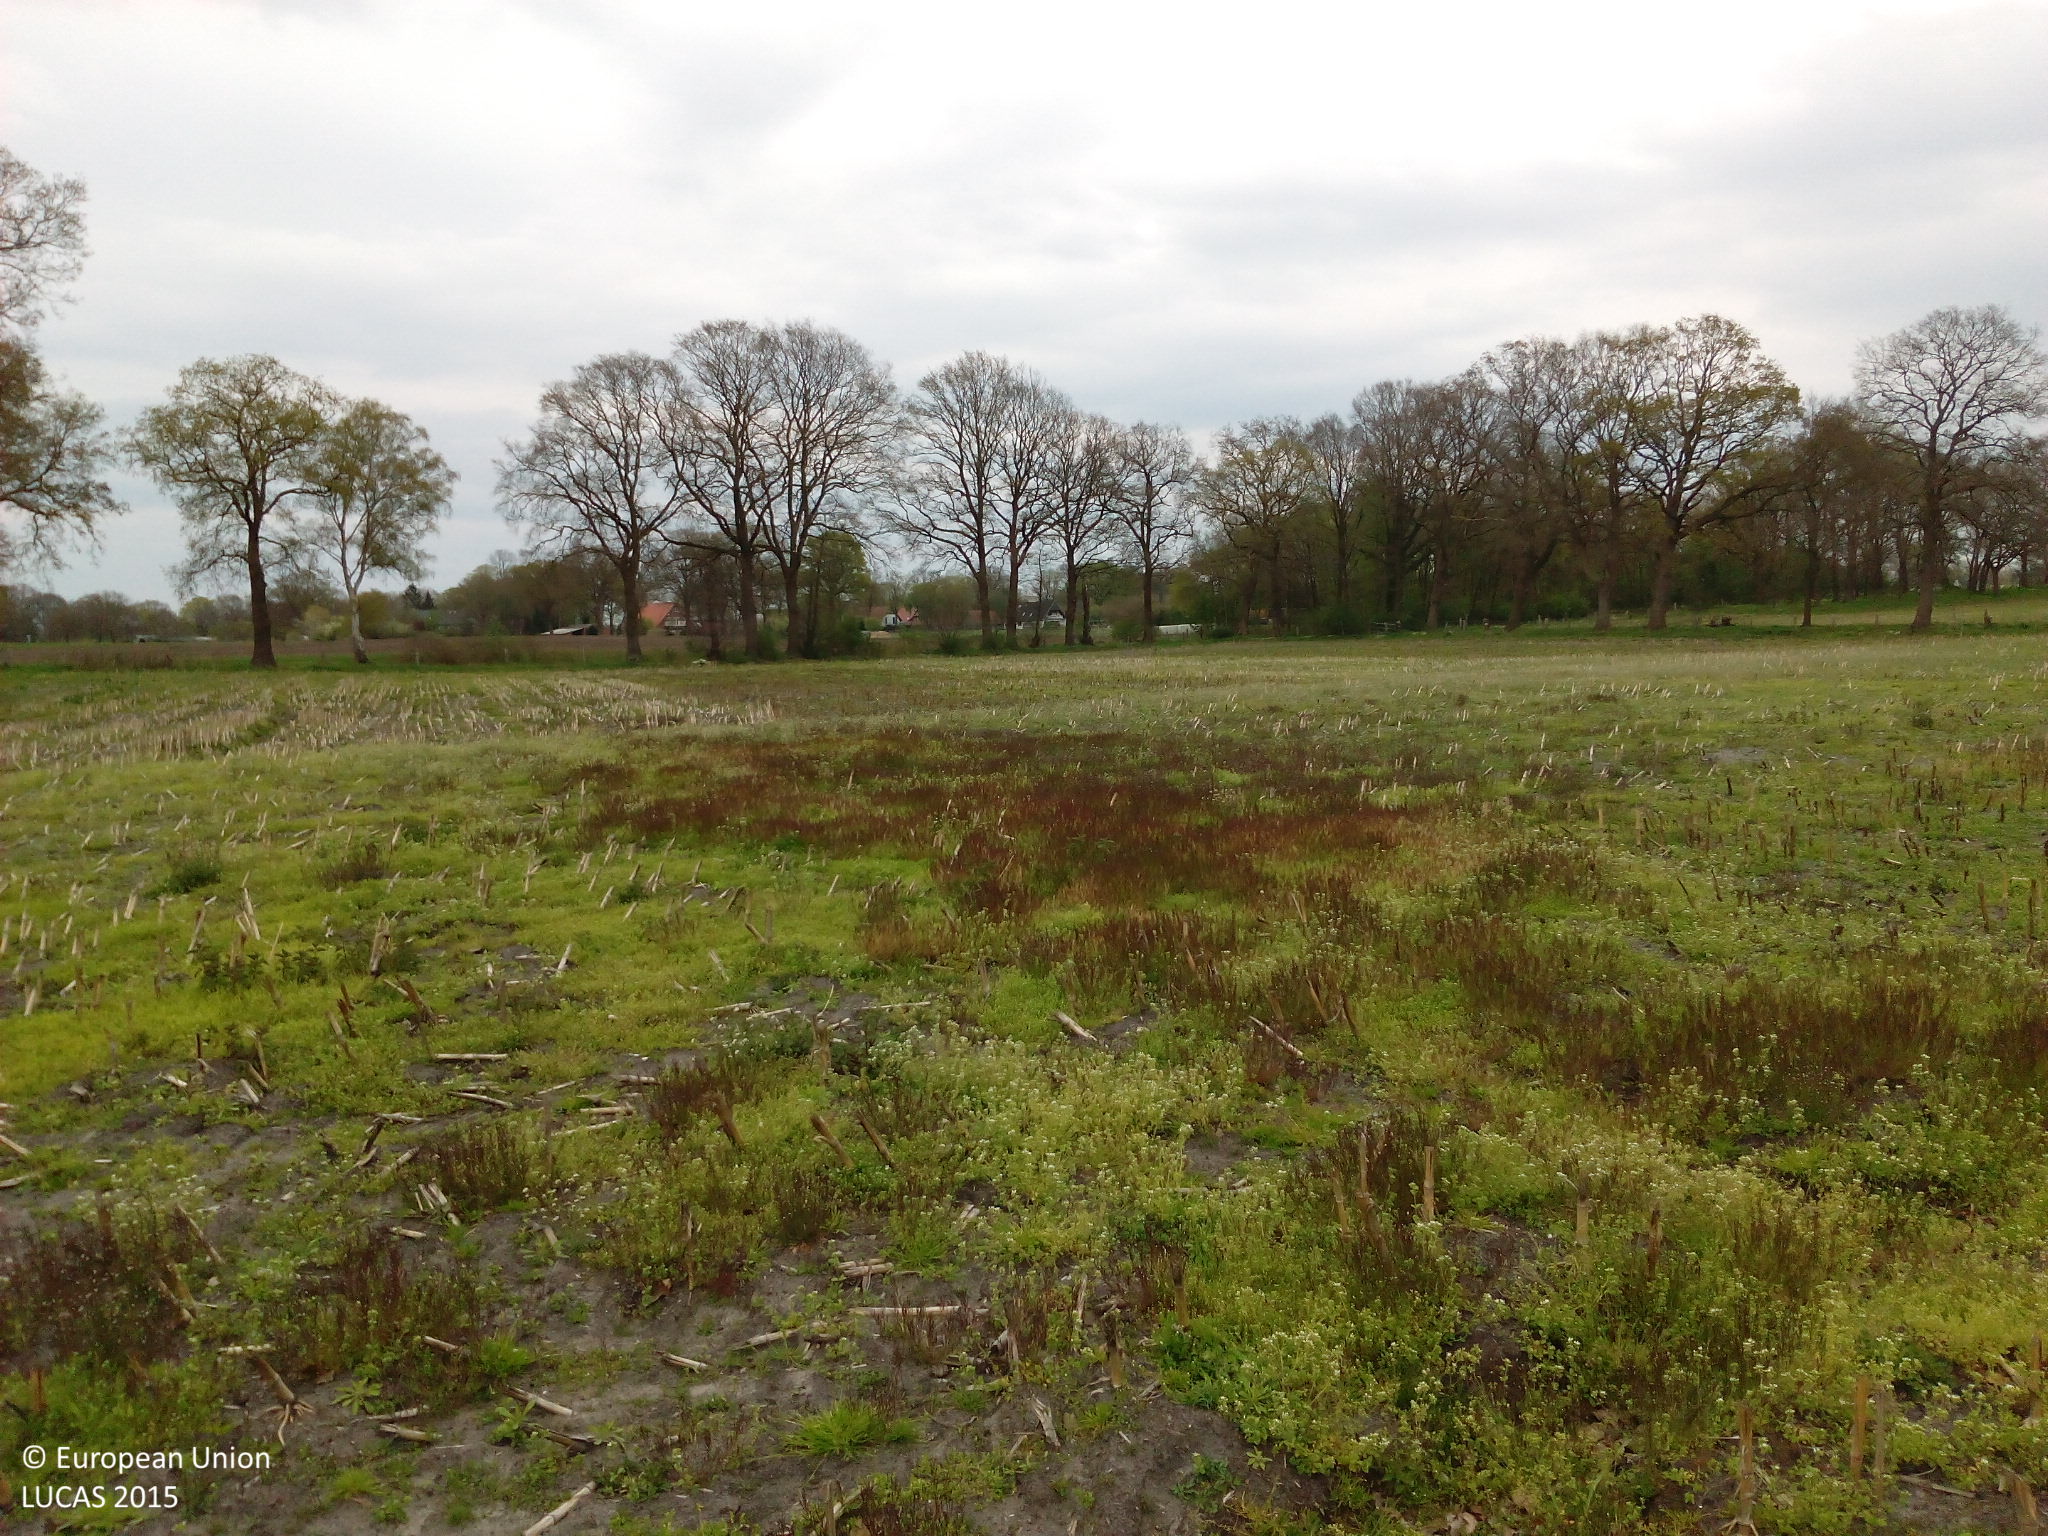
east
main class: Grassland
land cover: Spontaneously vegetated surfaces
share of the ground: 50 - 75 %
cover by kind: herbaceous plants 50 %, consolidated bare surface 30 %, lichens and mosses 20 %
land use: Fallow land
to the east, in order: Spontaneously vegetated surfaces; Fences; Broadleaved woodland; Grassland without tree/shrub cover; Other bare soil
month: May
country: DE
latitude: 53.2498
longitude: 8.5768
